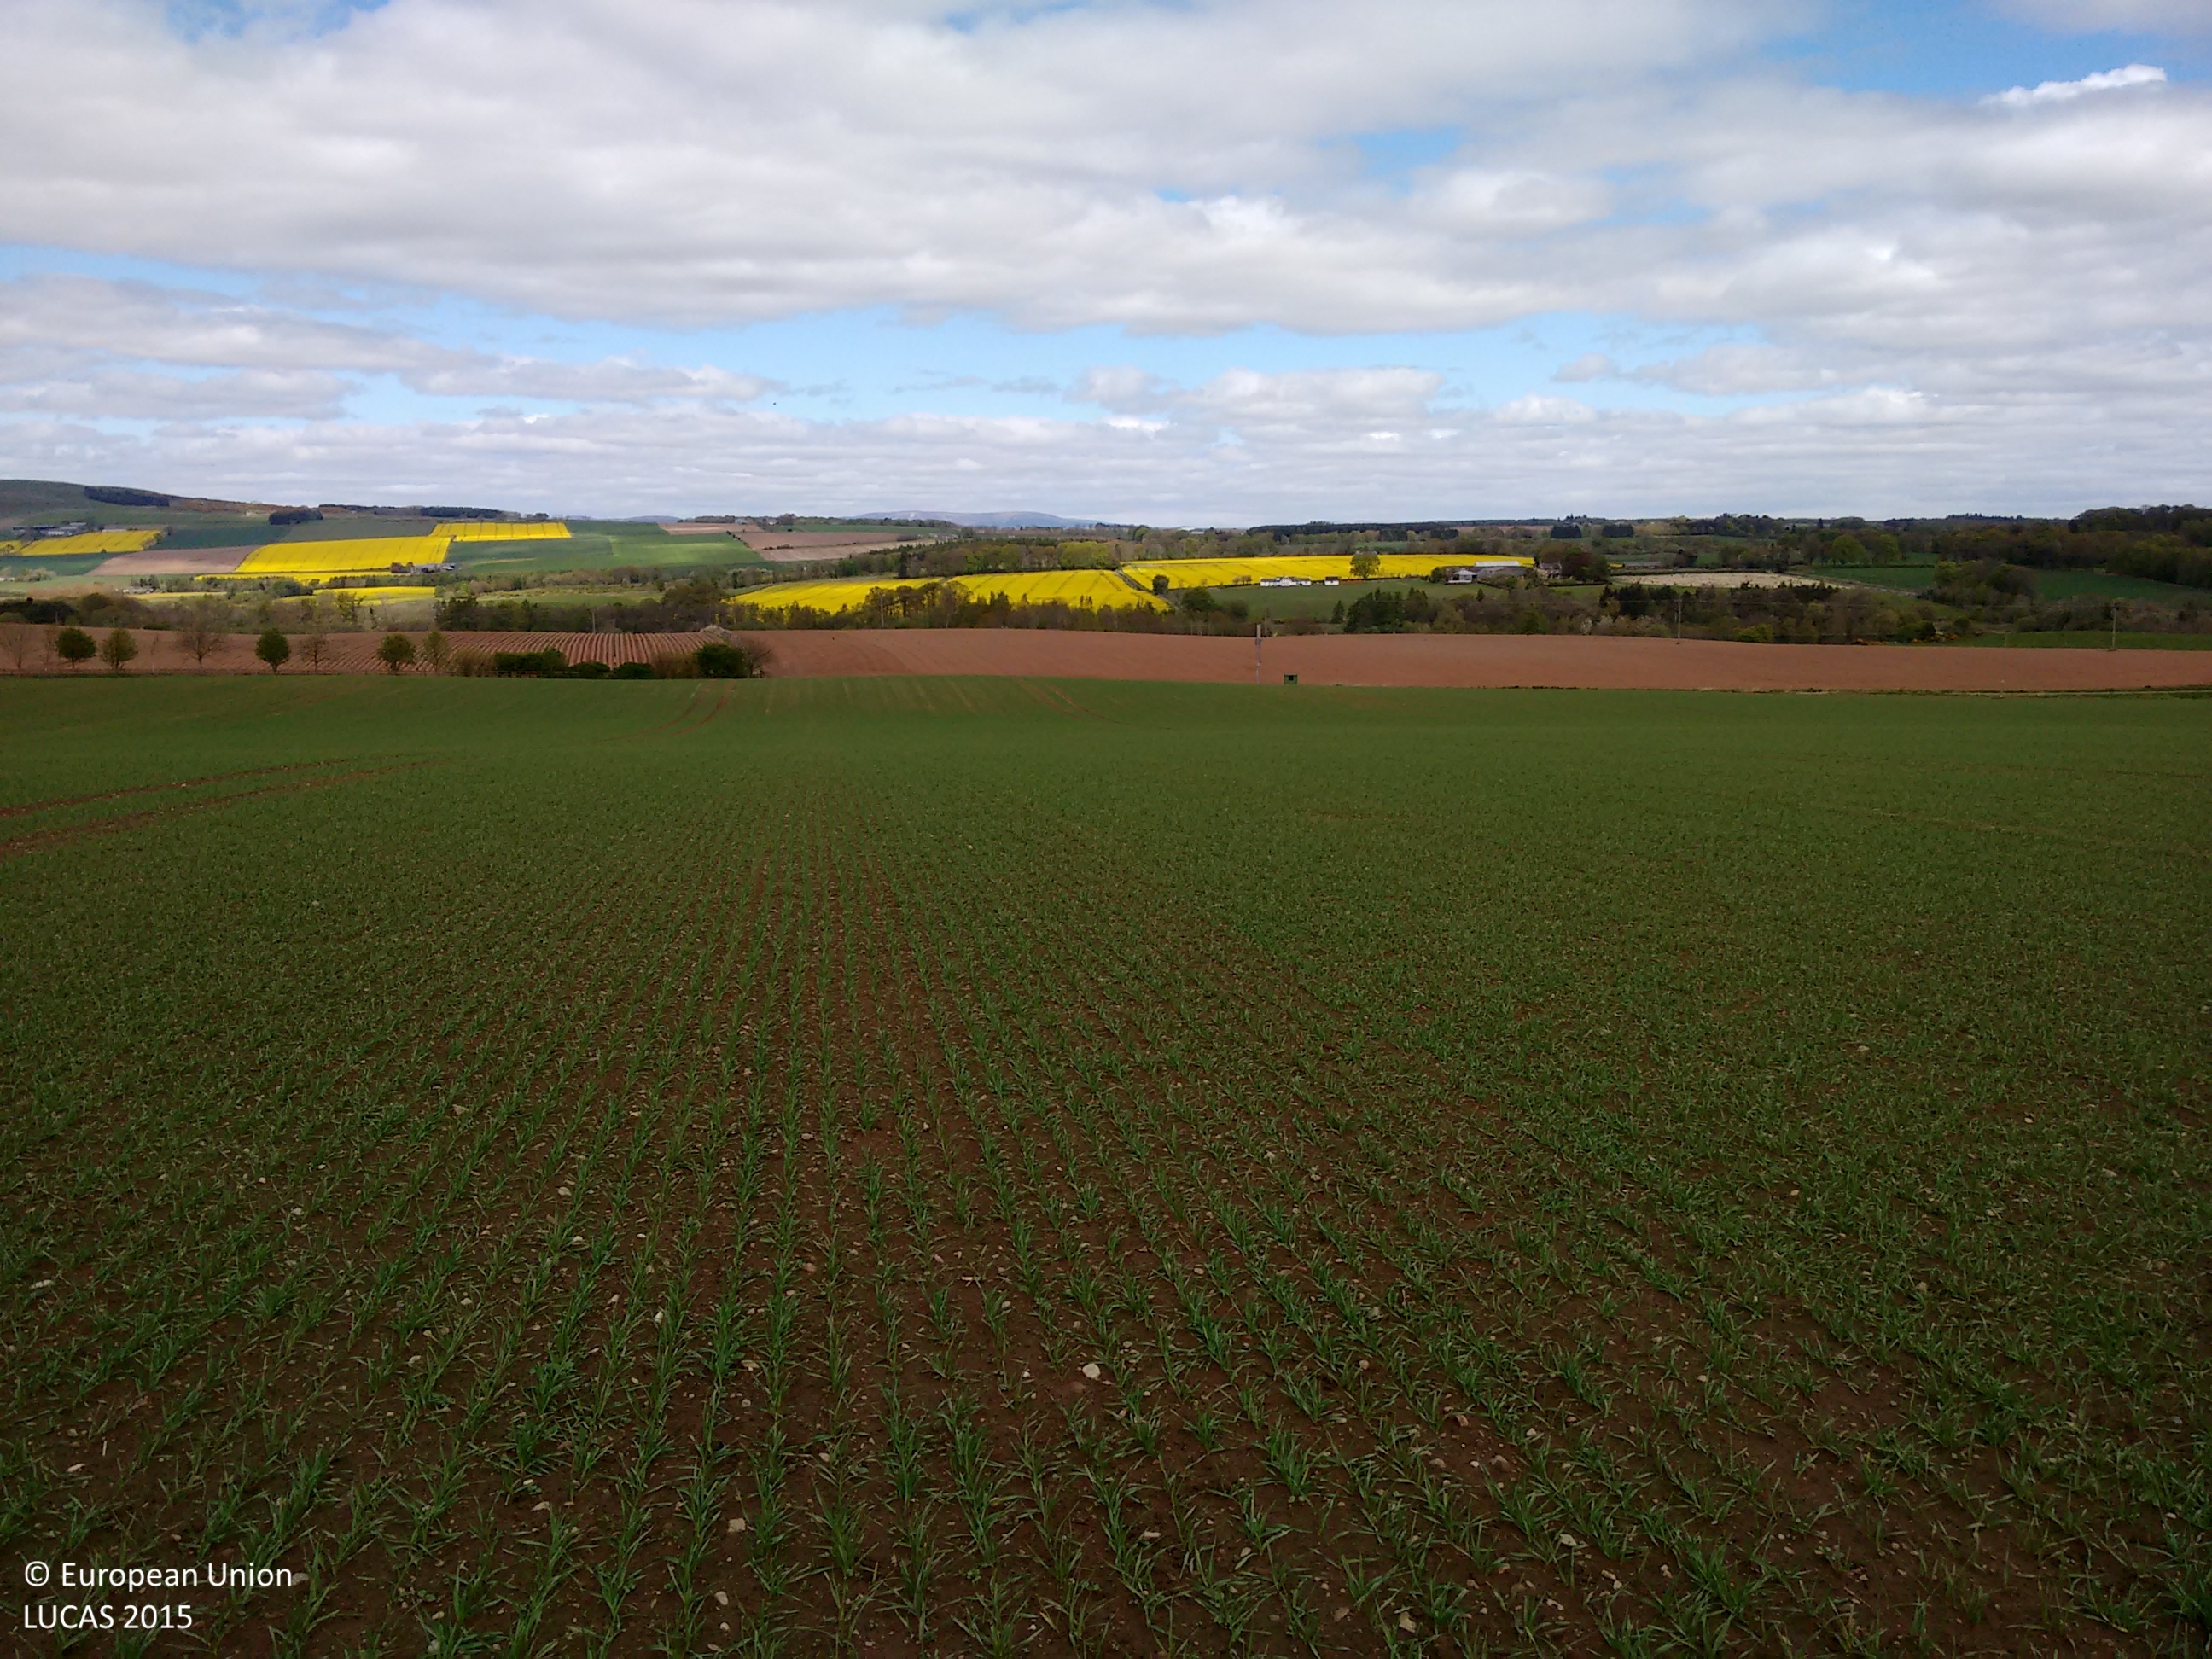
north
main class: Cropland
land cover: Barley
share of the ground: 25 - 50 %
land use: Agriculture (excluding fallow land and kitchen gardens)
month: May
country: GB
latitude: 56.6410
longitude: -2.7634
